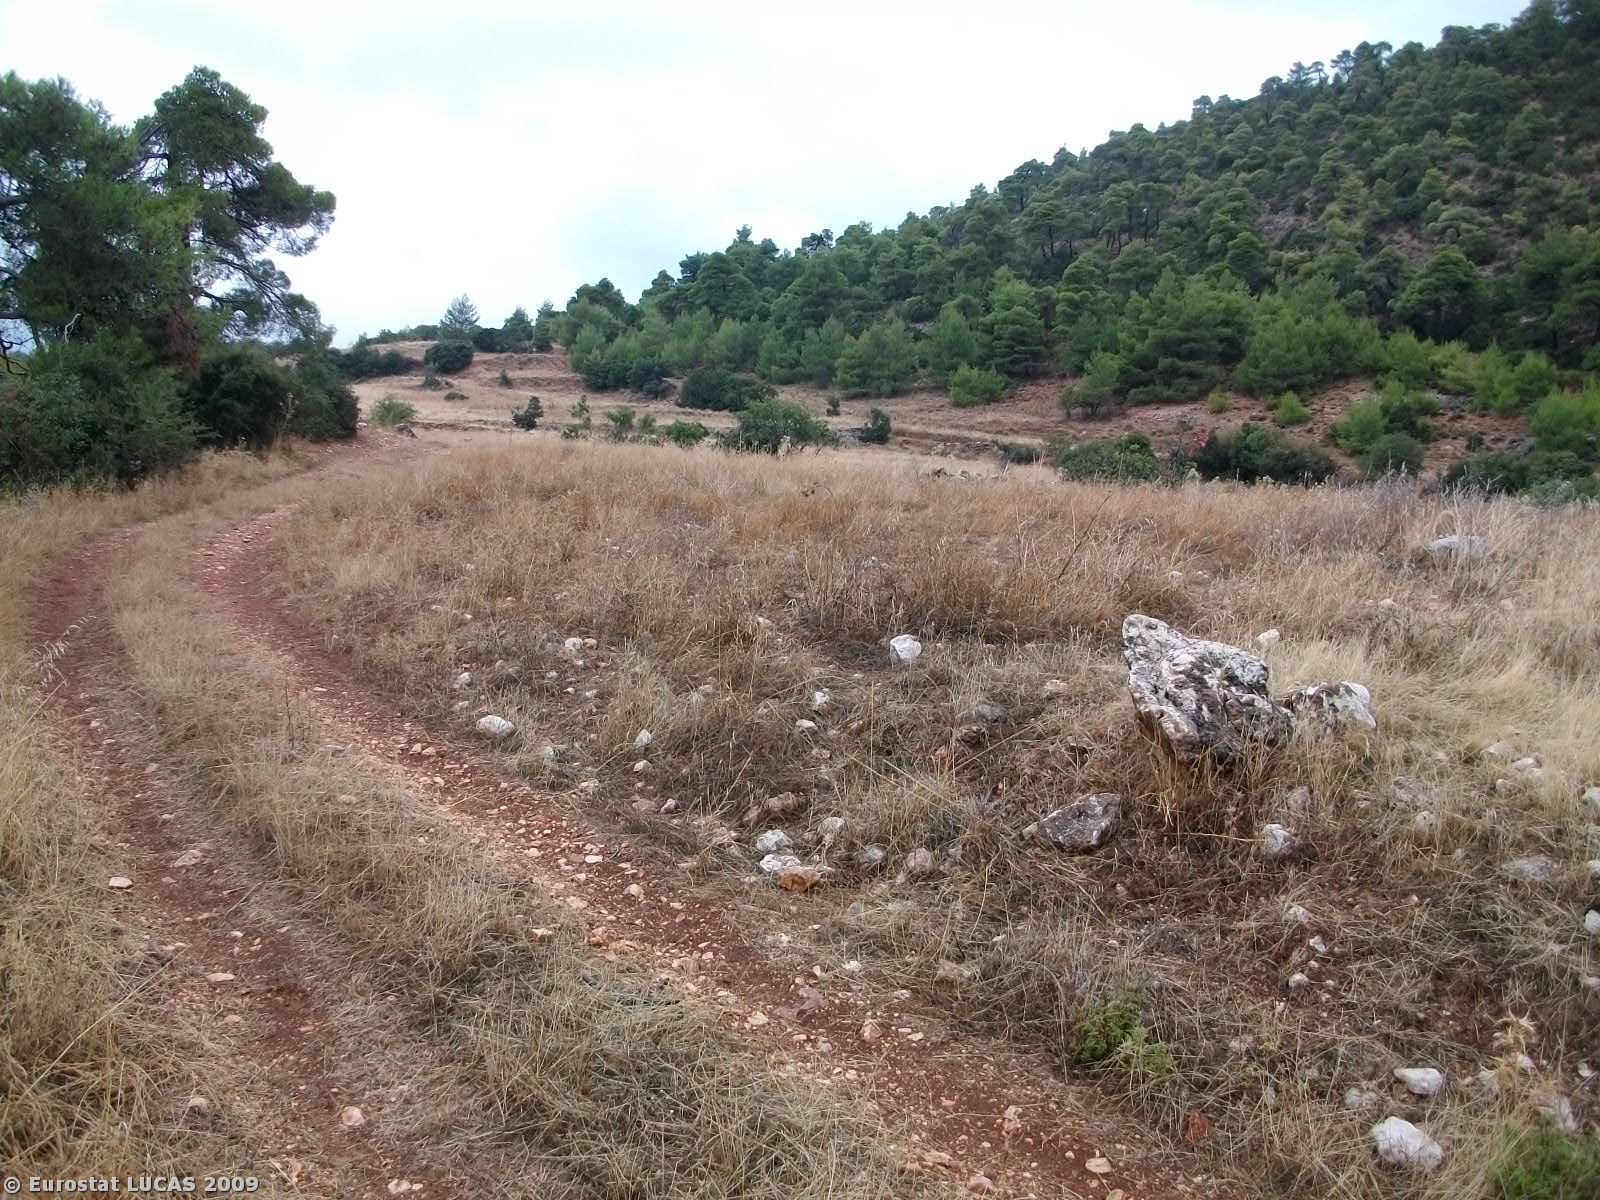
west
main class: Woodland
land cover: Coniferous woodland
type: coniferous forest of the mediterranean region
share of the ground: > 75 %
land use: Forestry
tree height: > 5 m
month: September
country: GR
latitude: 37.7902
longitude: 22.9726
